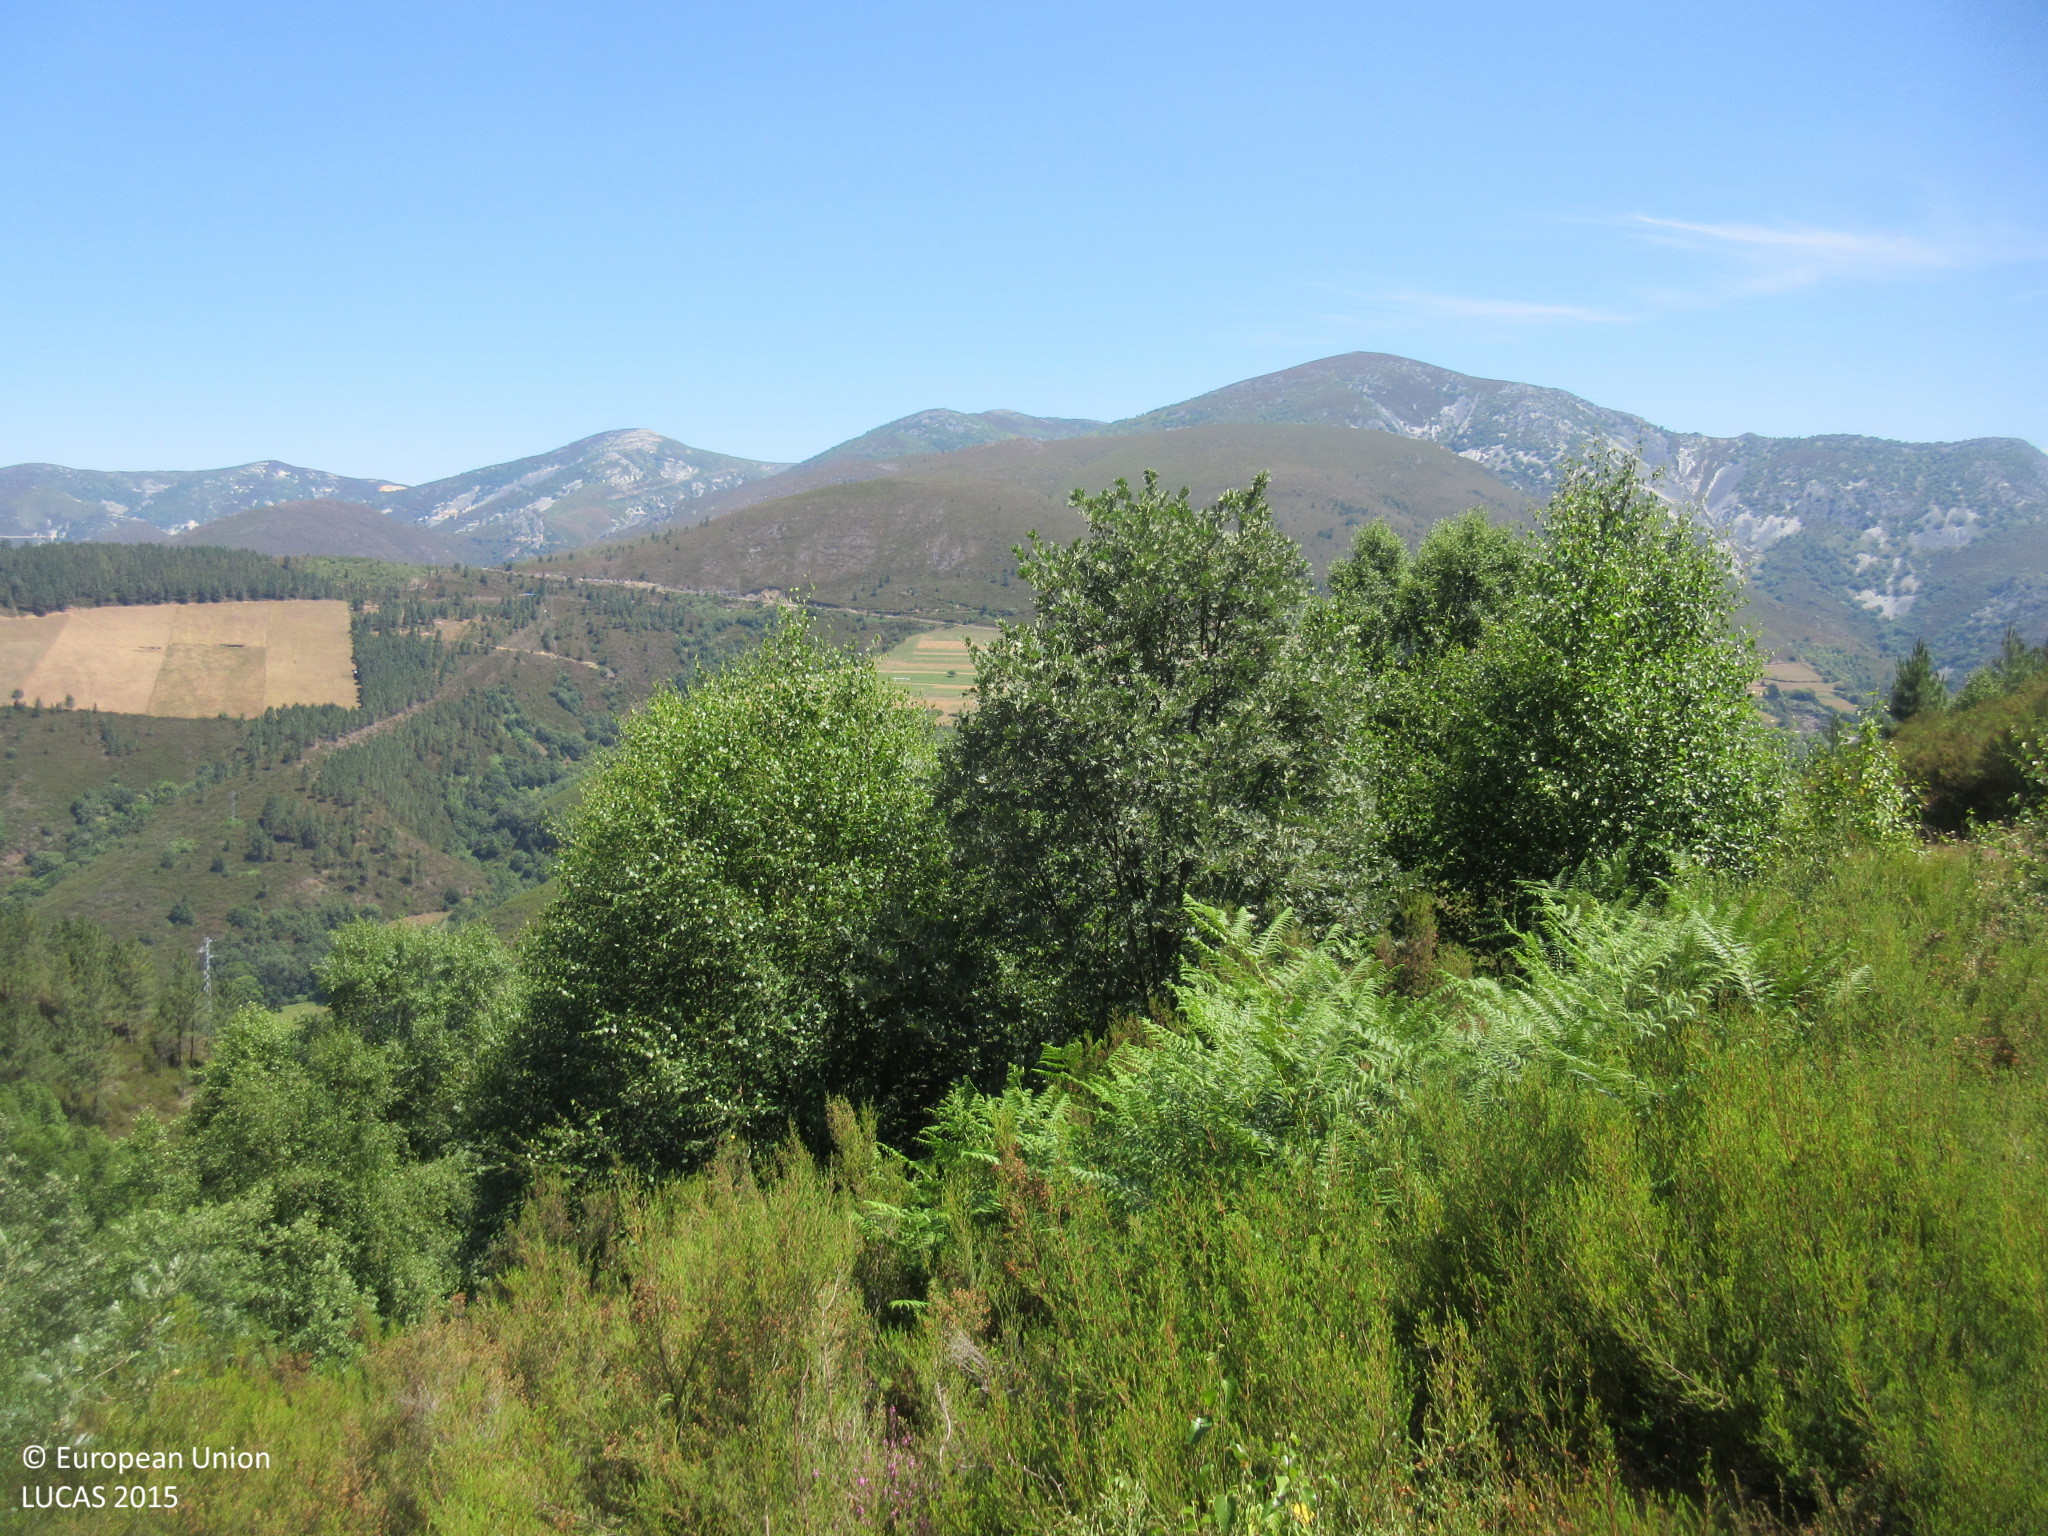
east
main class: Shrubland
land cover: Shrubland without tree cover
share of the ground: > 75 %
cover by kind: shrubs 100 %
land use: Forestry
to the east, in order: Shrubland without tree cover; Broadleaved woodland; Pine dominated coniferous woodland; Tracks; Pine dominated coniferous woodland
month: June
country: ES
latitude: 43.0538
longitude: -6.8420
